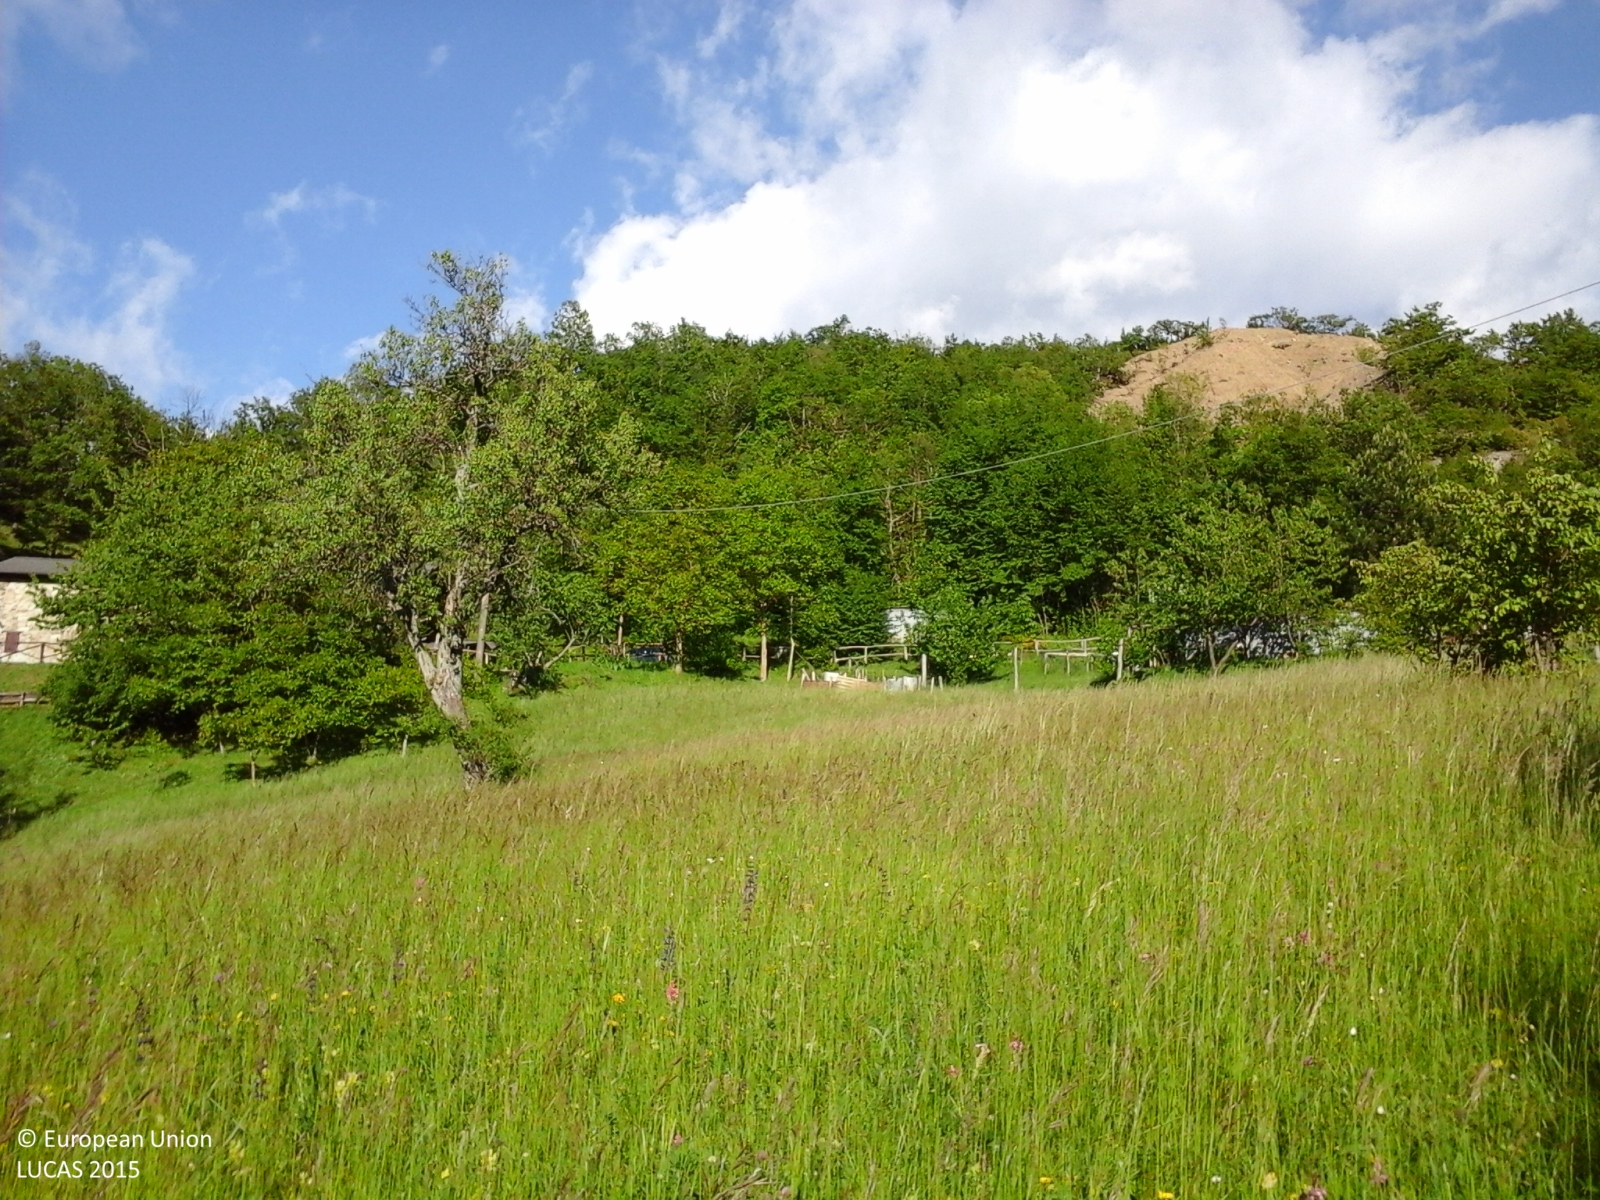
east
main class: Woodland
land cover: Broadleaved woodland
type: thermophilous deciduous forest
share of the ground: > 75 %
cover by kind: broadleaved forest trees 100 %
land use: Forestry
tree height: > 5 m
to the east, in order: Broadleaved woodland; Grassland without tree/shrub cover; Fences; Tomatoes; Fences; Electric lines; Broadleaved woodland; Fences; Tracks; Broadleaved woodland
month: May
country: IT
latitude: 44.5128
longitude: 9.8870
